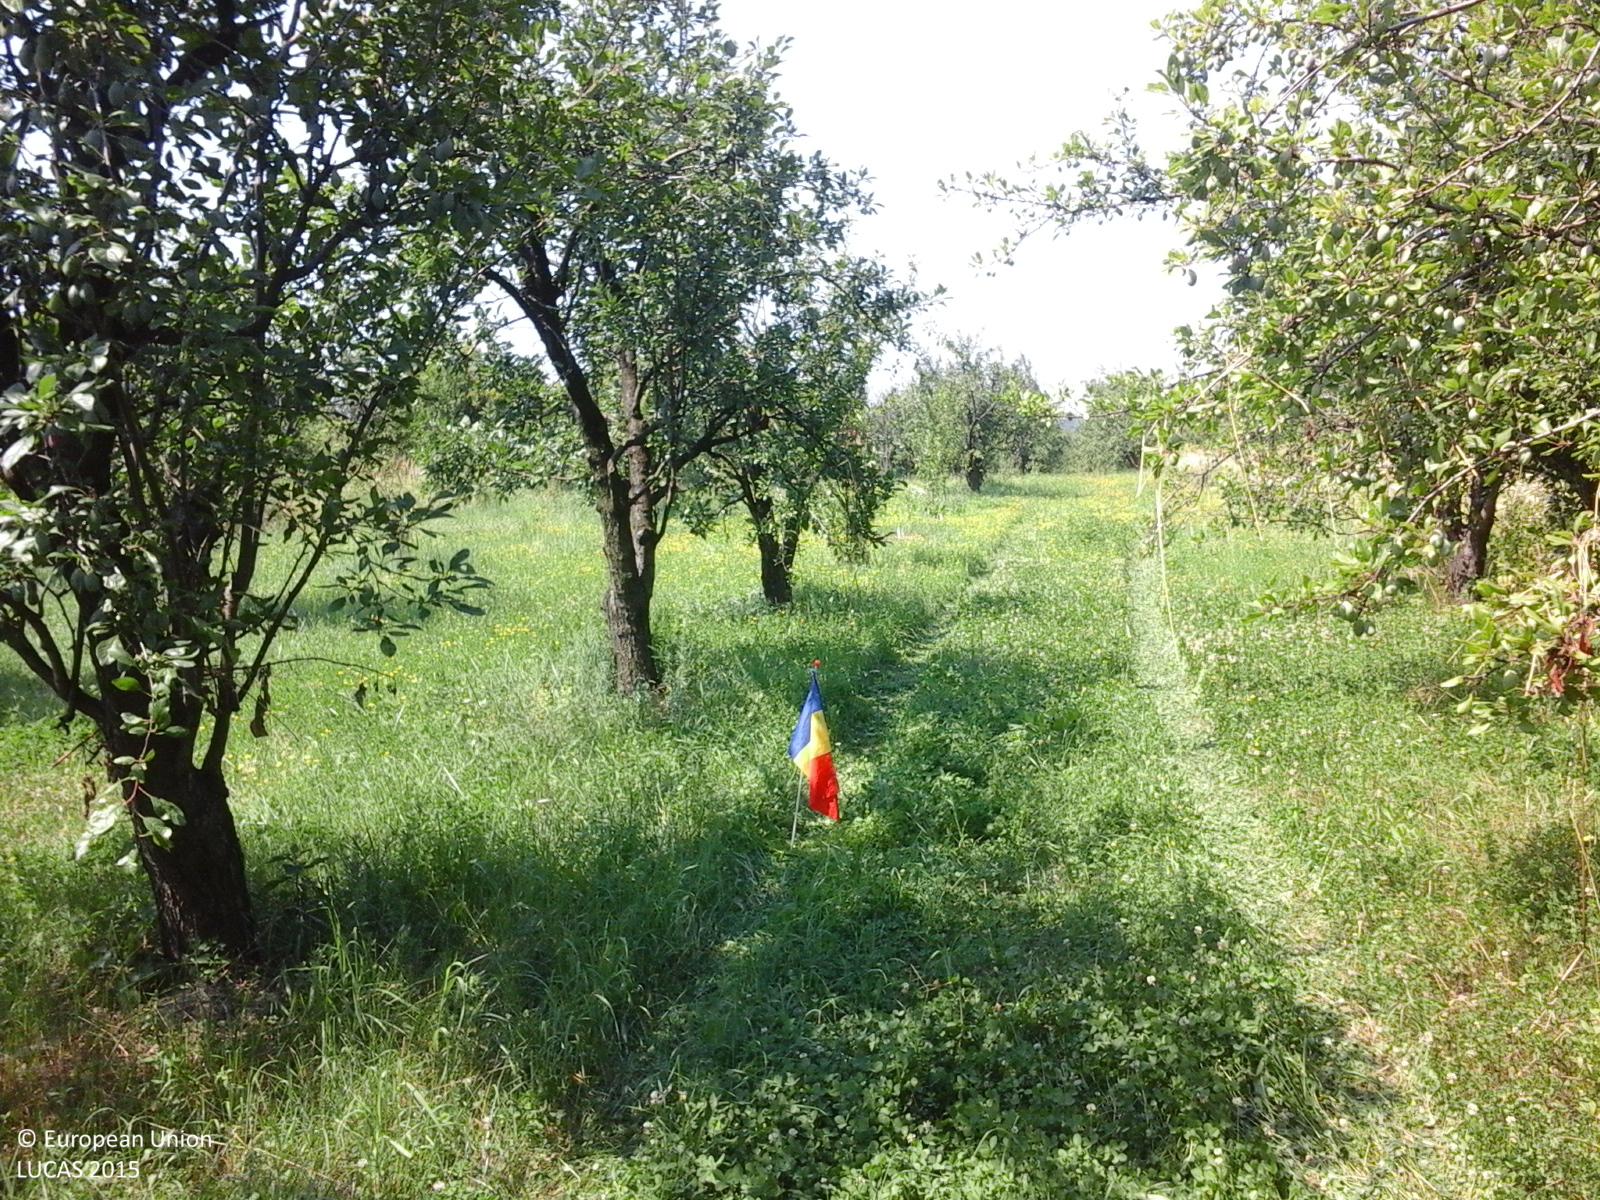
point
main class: Cropland
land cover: Other fruit trees and berries
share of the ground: > 75 %
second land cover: Grassland without tree/shrub cover
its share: 25 - 50 %
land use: Agriculture (excluding fallow land and kitchen gardens)
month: July
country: RO
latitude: 44.8333
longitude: 25.4629
